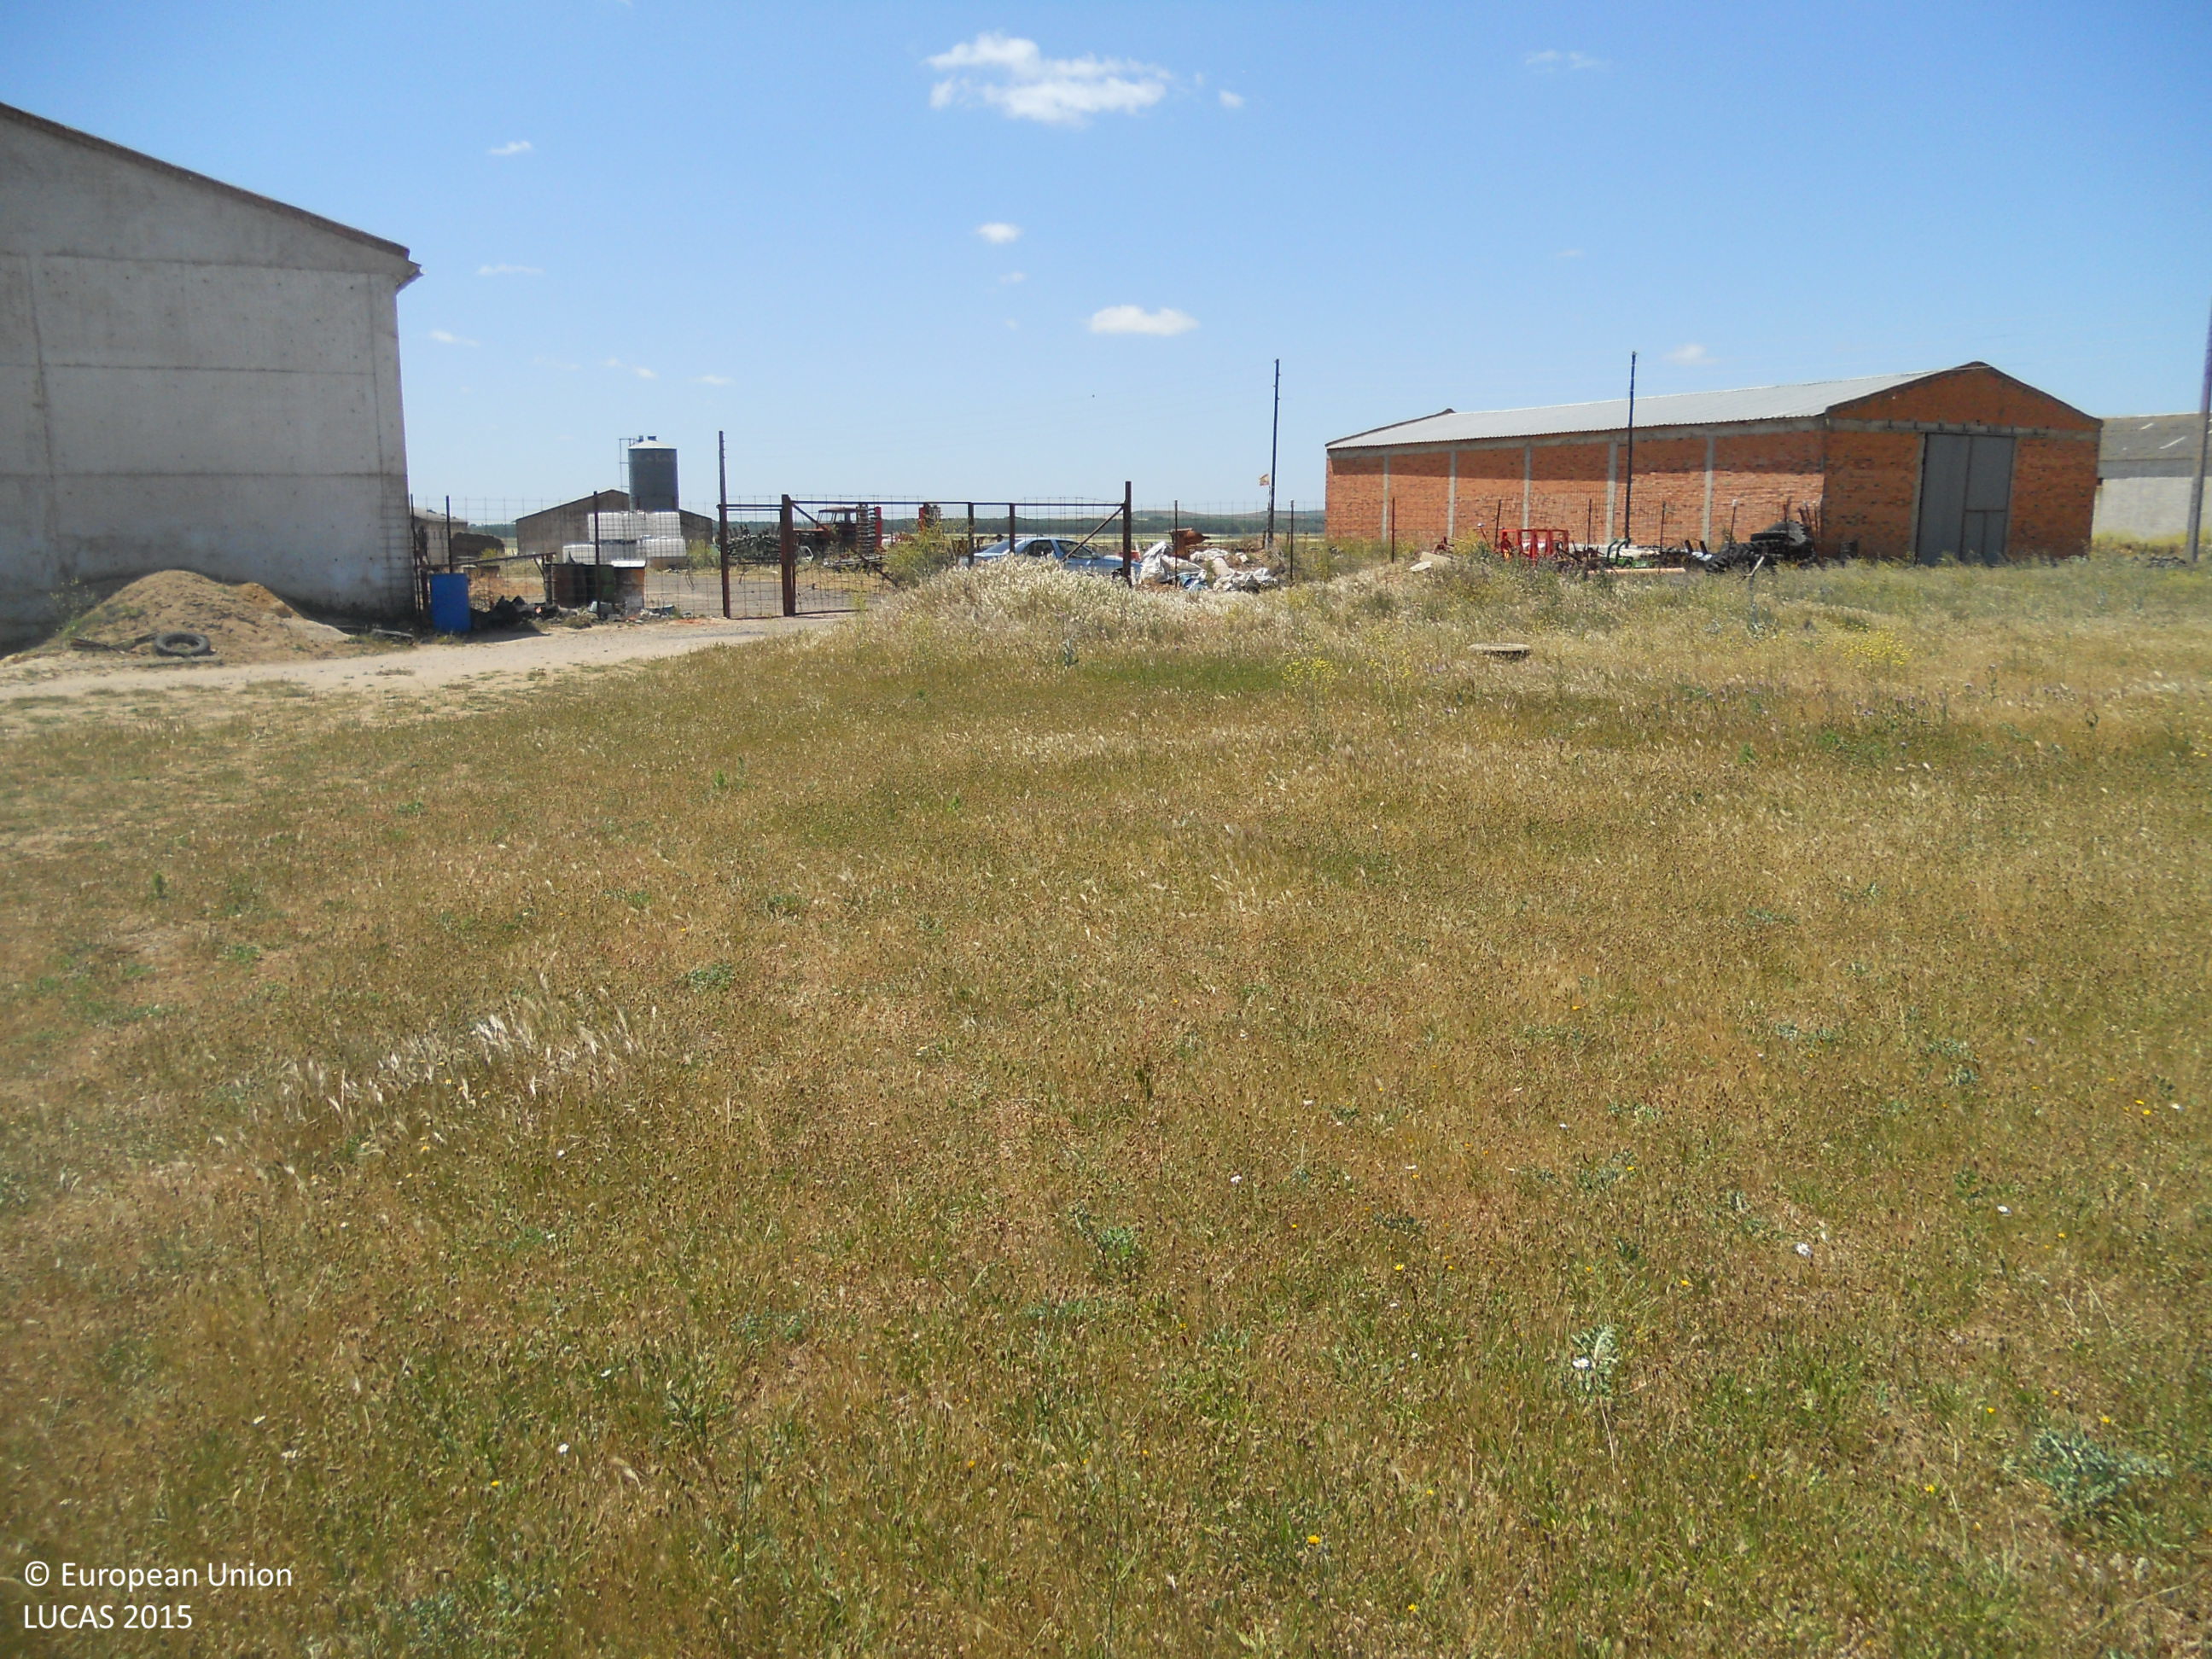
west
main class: Grassland
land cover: Grassland without tree/shrub cover
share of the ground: > 75 %
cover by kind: herbaceous plants 100 %
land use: Agriculture (excluding fallow land and kitchen gardens)
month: May
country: ES
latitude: 42.3565
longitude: -4.2376
